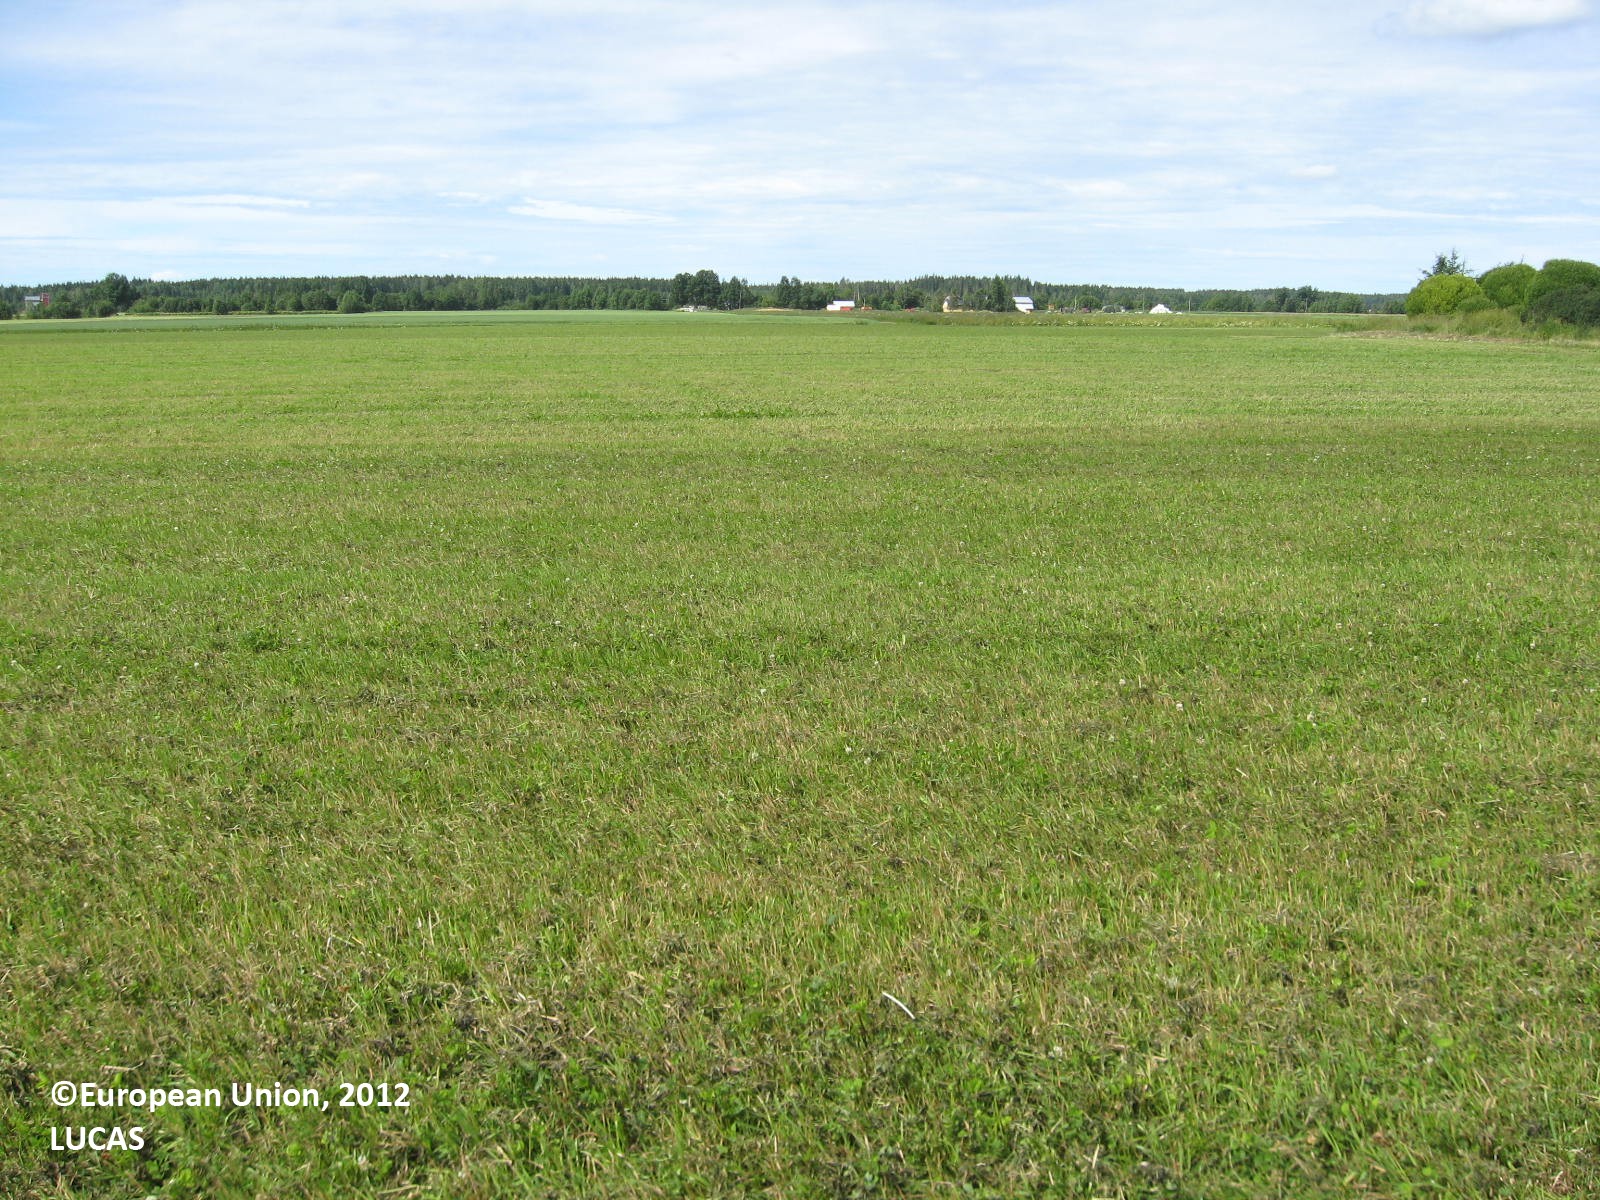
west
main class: Cropland
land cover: Clovers
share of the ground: > 75 %
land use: Agriculture (excluding fallow land and kitchen gardens)
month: July
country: FI
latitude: 62.3292
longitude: 21.5689
